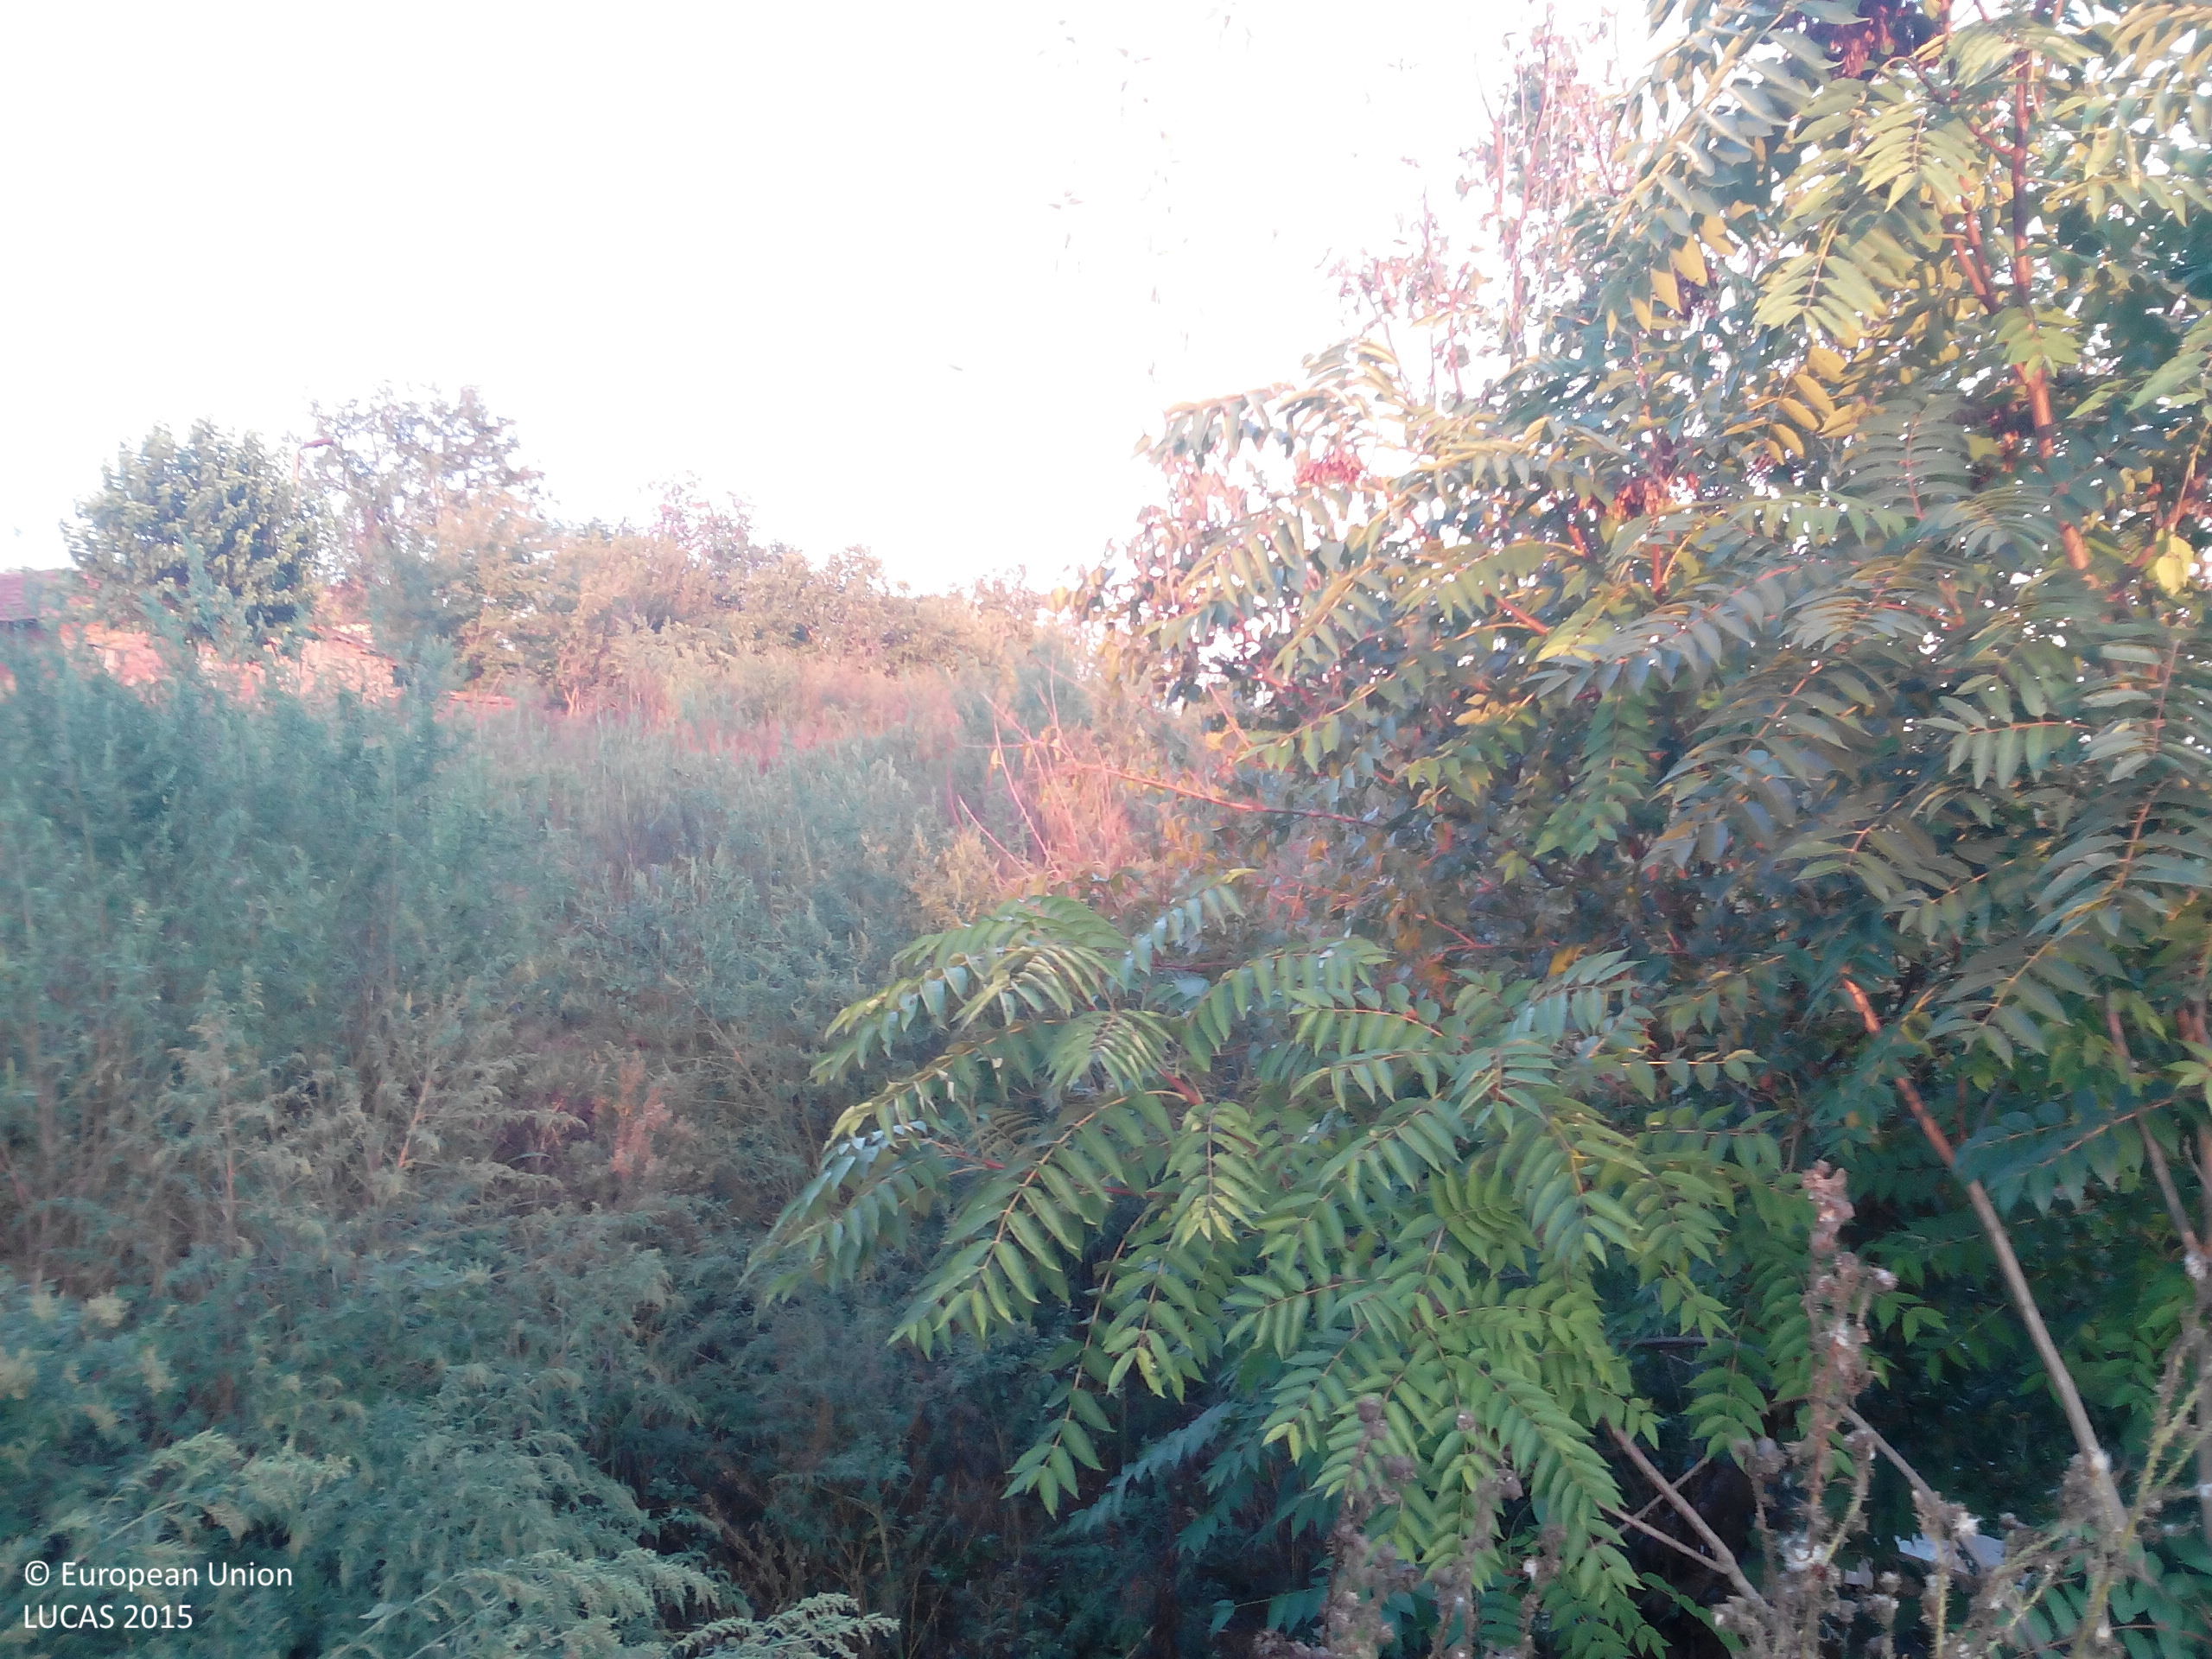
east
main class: Woodland
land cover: Broadleaved woodland
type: mesophytic deciduous forest
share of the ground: 25 - 50 %
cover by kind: herbaceous plants 60 %, broadleaved forest trees 30 %, shrubs 10 %
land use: Semi-natural and natural areas not in use
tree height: > 5 m
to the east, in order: Broadleaved woodland; Rivers and streams; Grassland without tree/shrub cover; Tracks; Grassland without tree/shrub cover; Tracks; Artificial constructions in urban areas
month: October
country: BG
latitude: 43.5589
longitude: 23.8792
